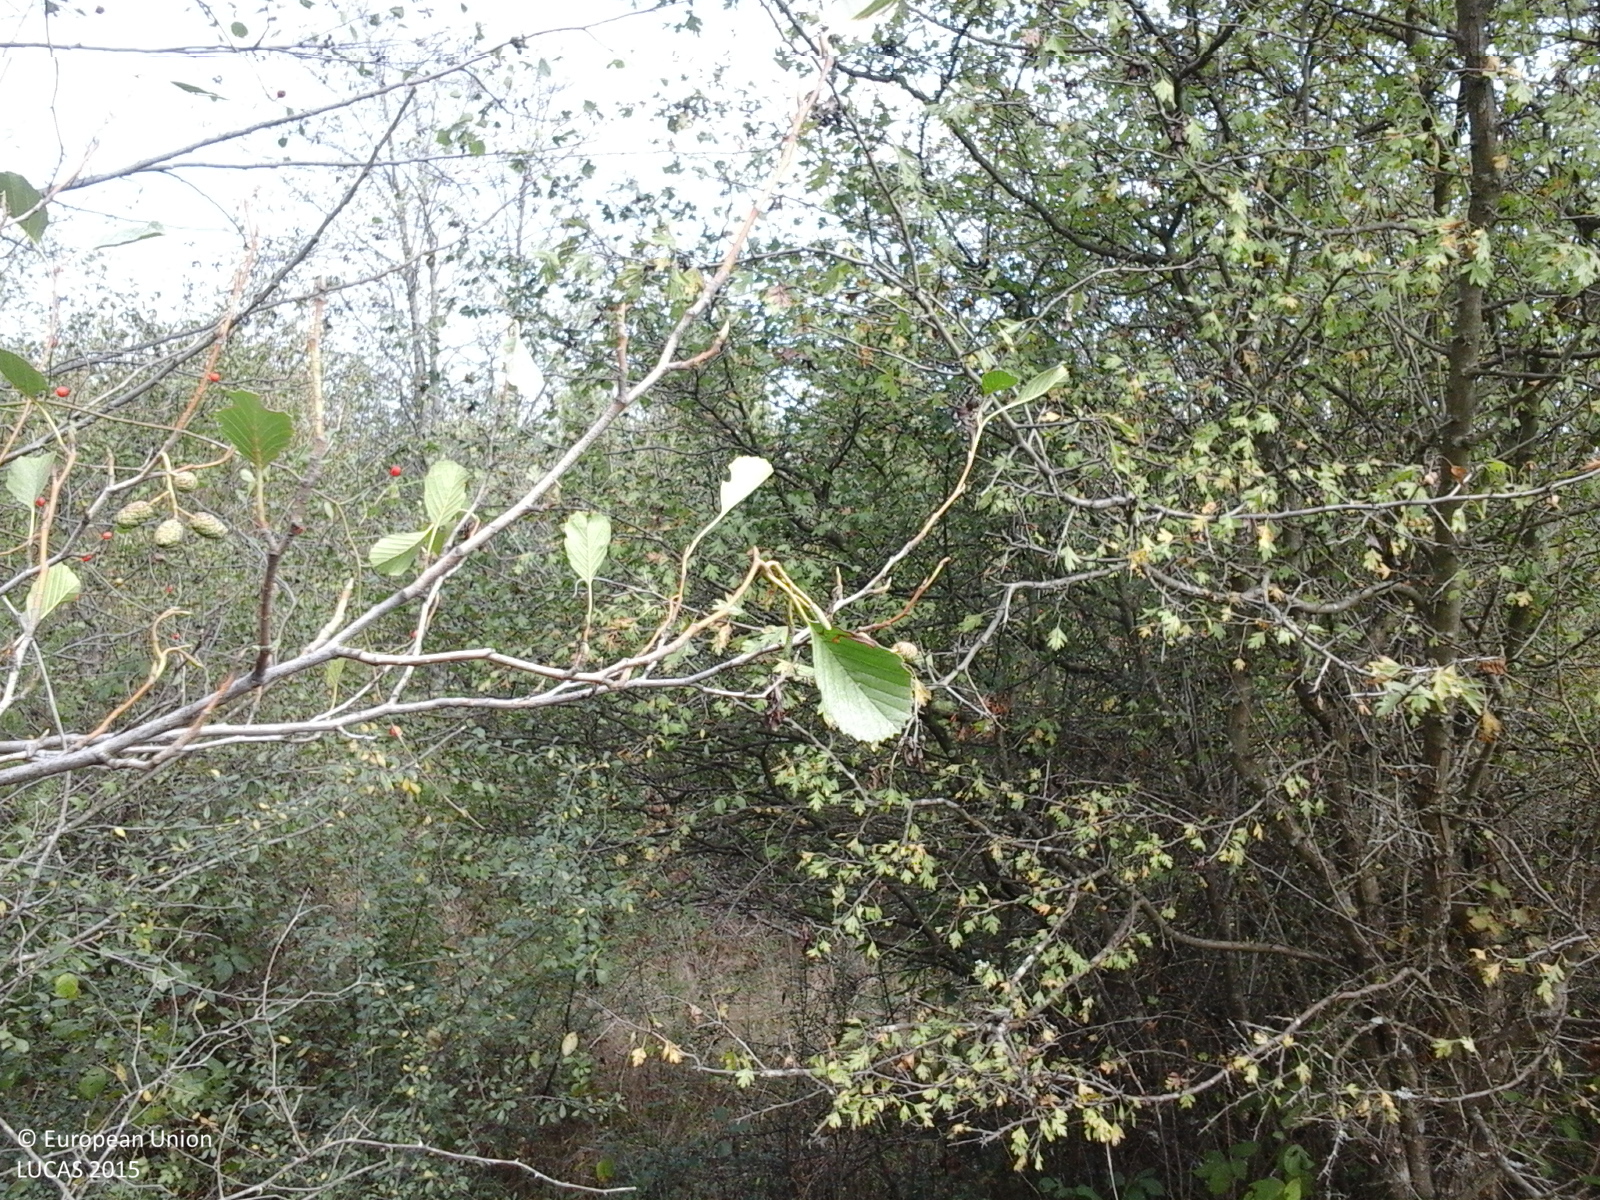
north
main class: Grassland
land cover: Grassland with sparse tree/shrub cover
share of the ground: > 75 %
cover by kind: herbaceous plants 85 %, shrubs 10 %, coniferous forest trees 5 %
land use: Agriculture (excluding fallow land and kitchen gardens)
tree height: < 5 m
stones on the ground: < 10 %
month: September
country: RO
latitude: 45.4407
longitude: 22.2763
